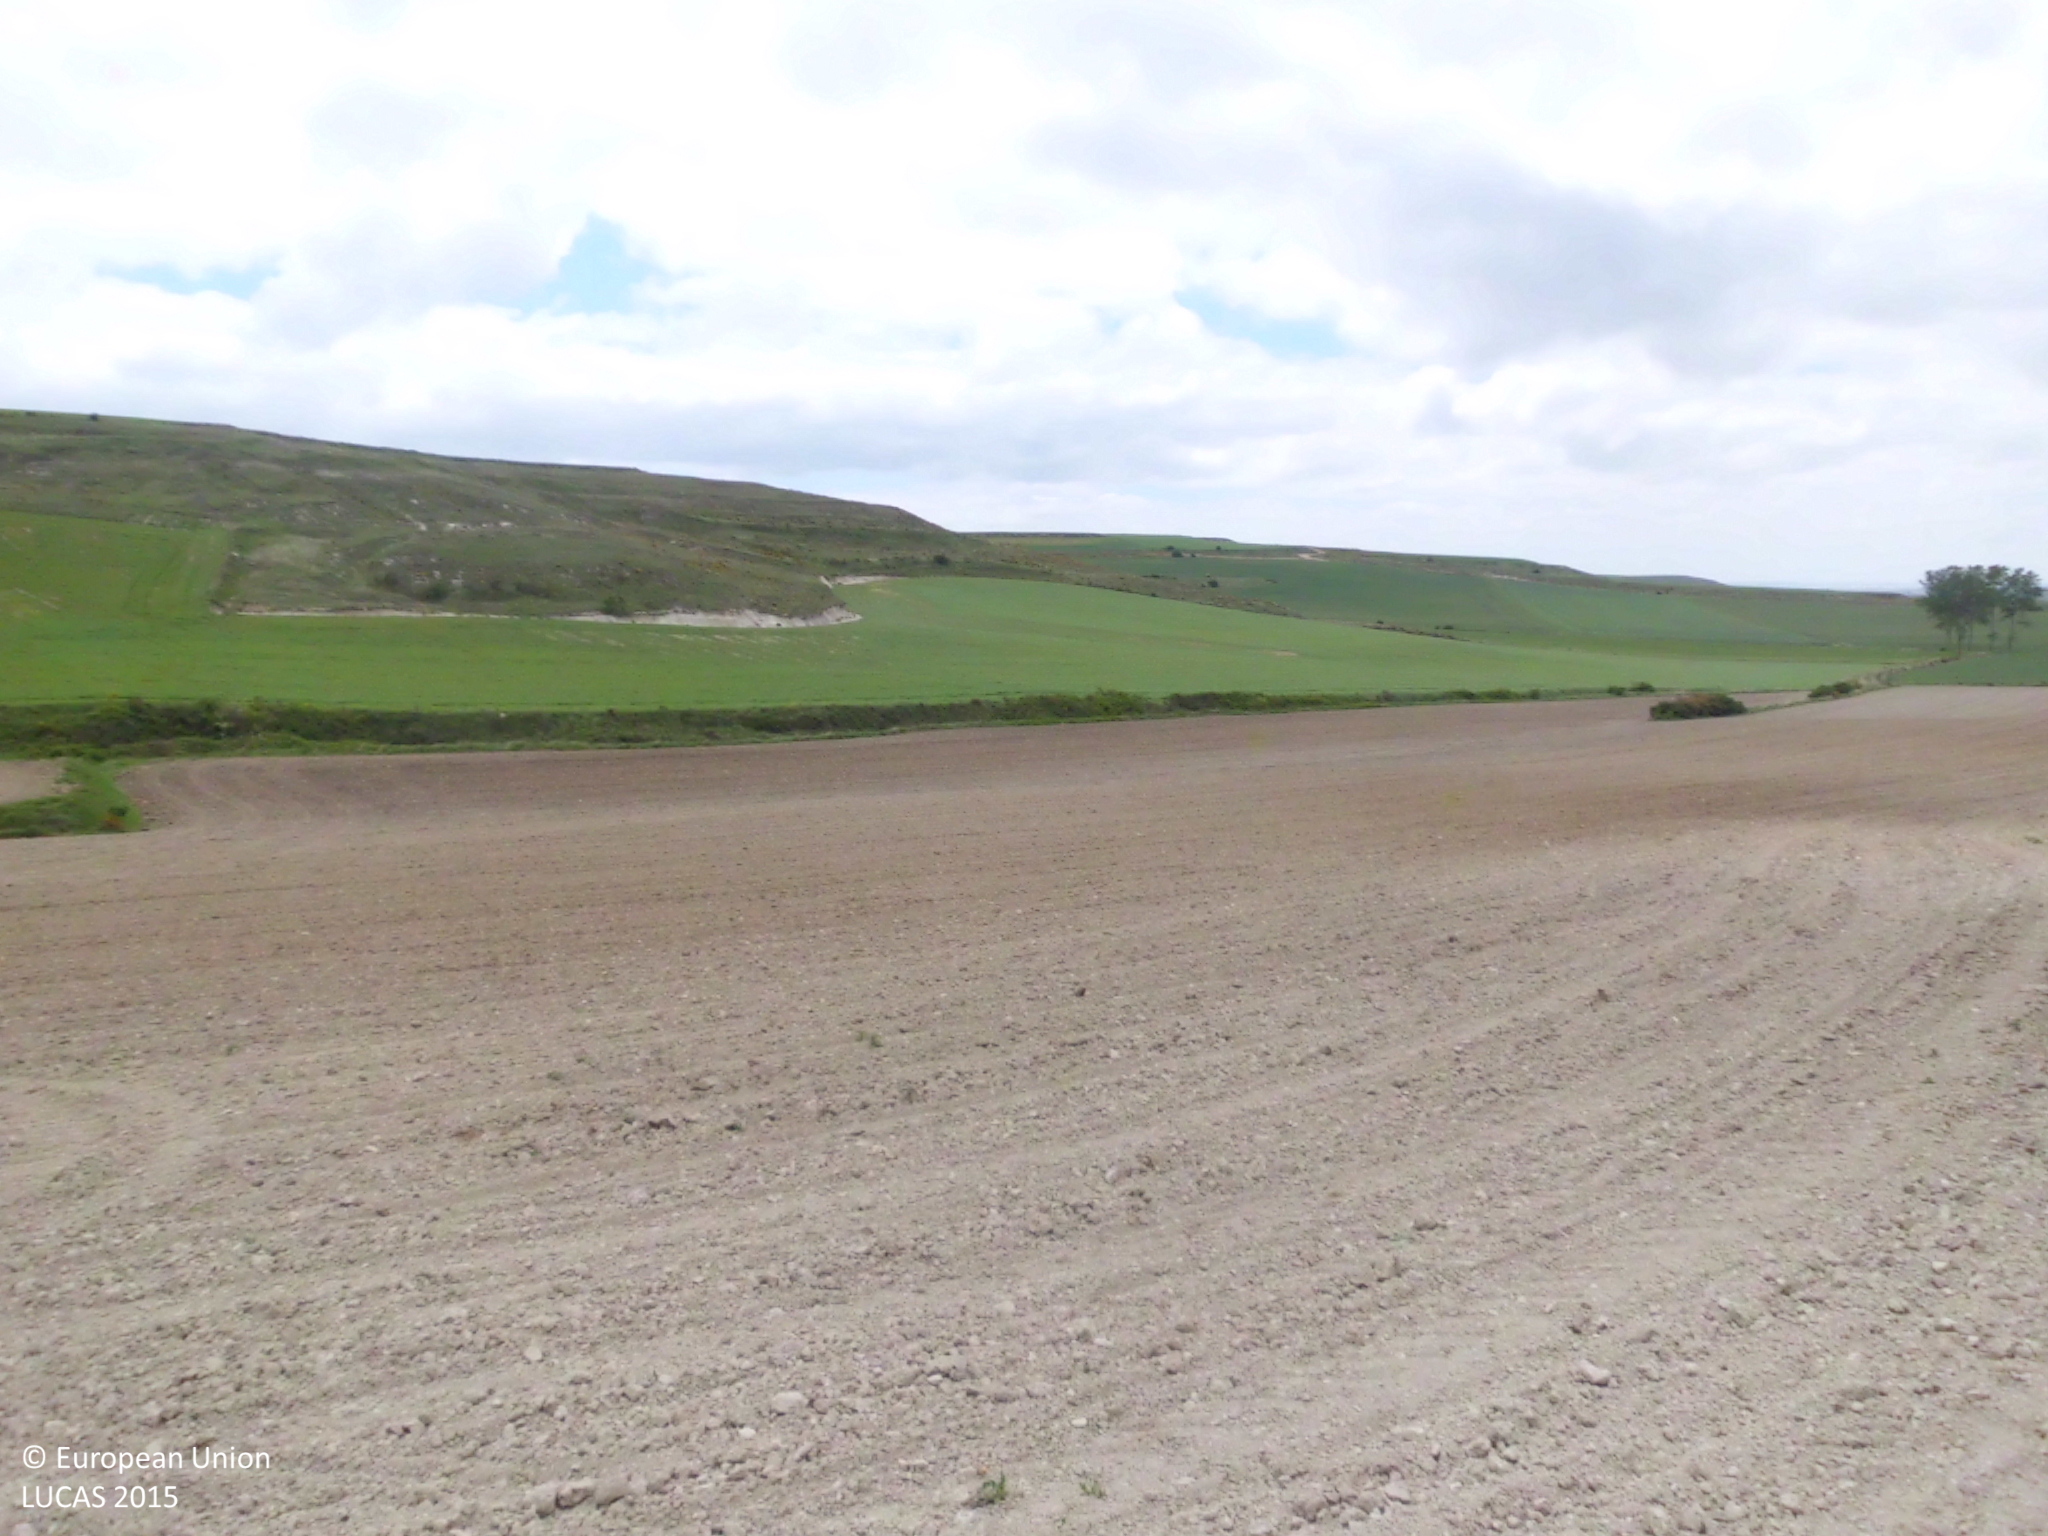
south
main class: Shrubland
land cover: Shrubland without tree cover
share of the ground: > 75 %
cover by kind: shrubs 60 %, herbaceous plants 40 %
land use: Semi-natural and natural areas not in use
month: May
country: ES
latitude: 42.5242
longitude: -3.9562
